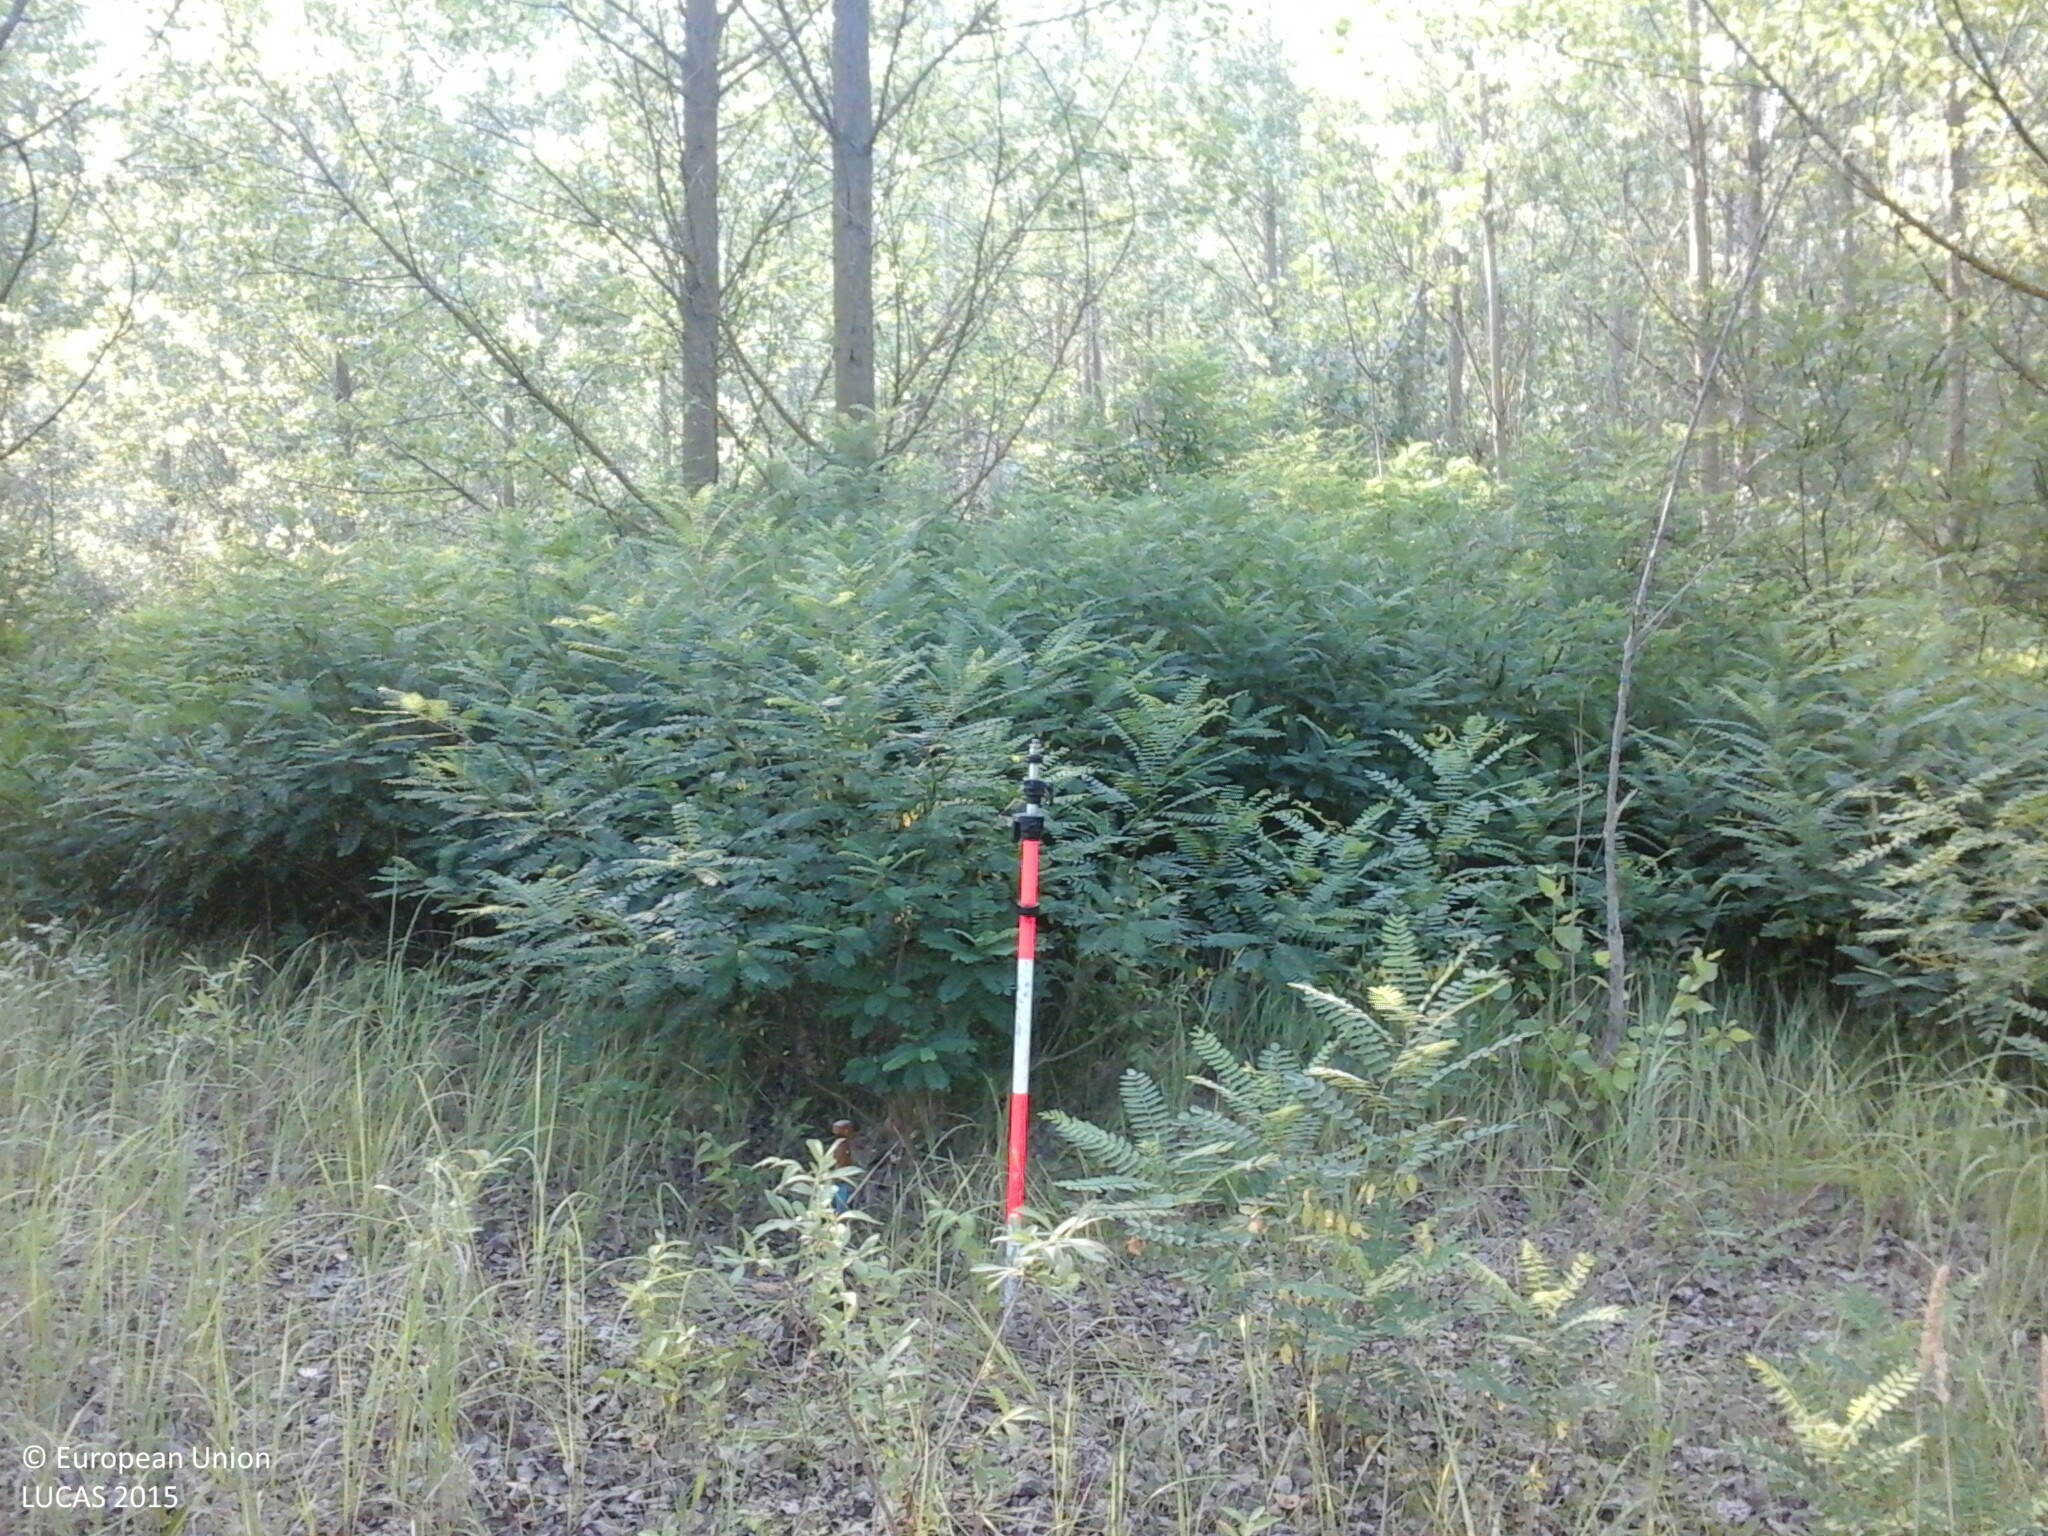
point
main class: Woodland
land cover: Broadleaved woodland
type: non-riverine alder, birch or aspen forest
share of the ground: > 75 %
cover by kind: broadleaved forest trees 95 %, herbaceous plants 5 %
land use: Forestry
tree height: > 5 m
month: July
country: HU
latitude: 47.7750
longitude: 22.4009
